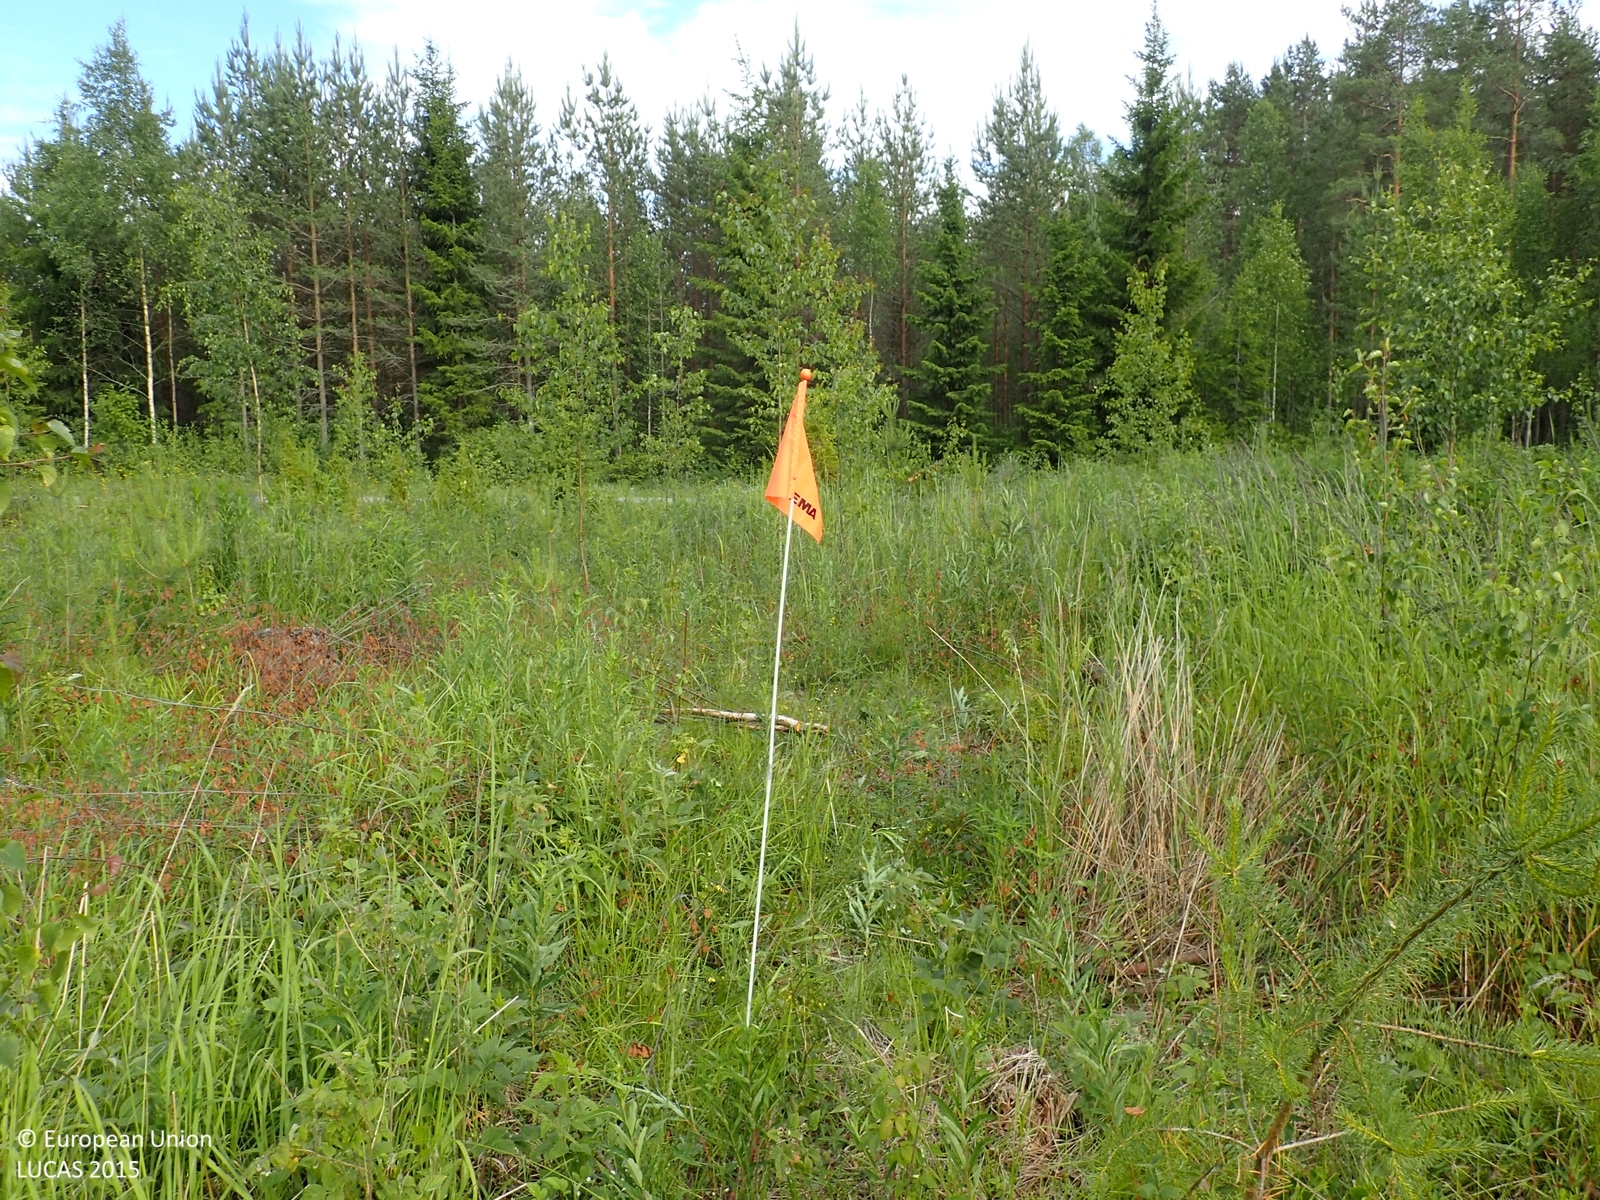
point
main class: Woodland
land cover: Broadleaved woodland
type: boreal forest
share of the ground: 10 - 25 %
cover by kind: herbaceous plants 75 %, broadleaved forest trees 15 %, coniferous forest trees 5 %, consolidated bare surface 5 %
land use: Forestry
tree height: < 5 m
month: July
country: FI
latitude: 62.6749
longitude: 21.3465
